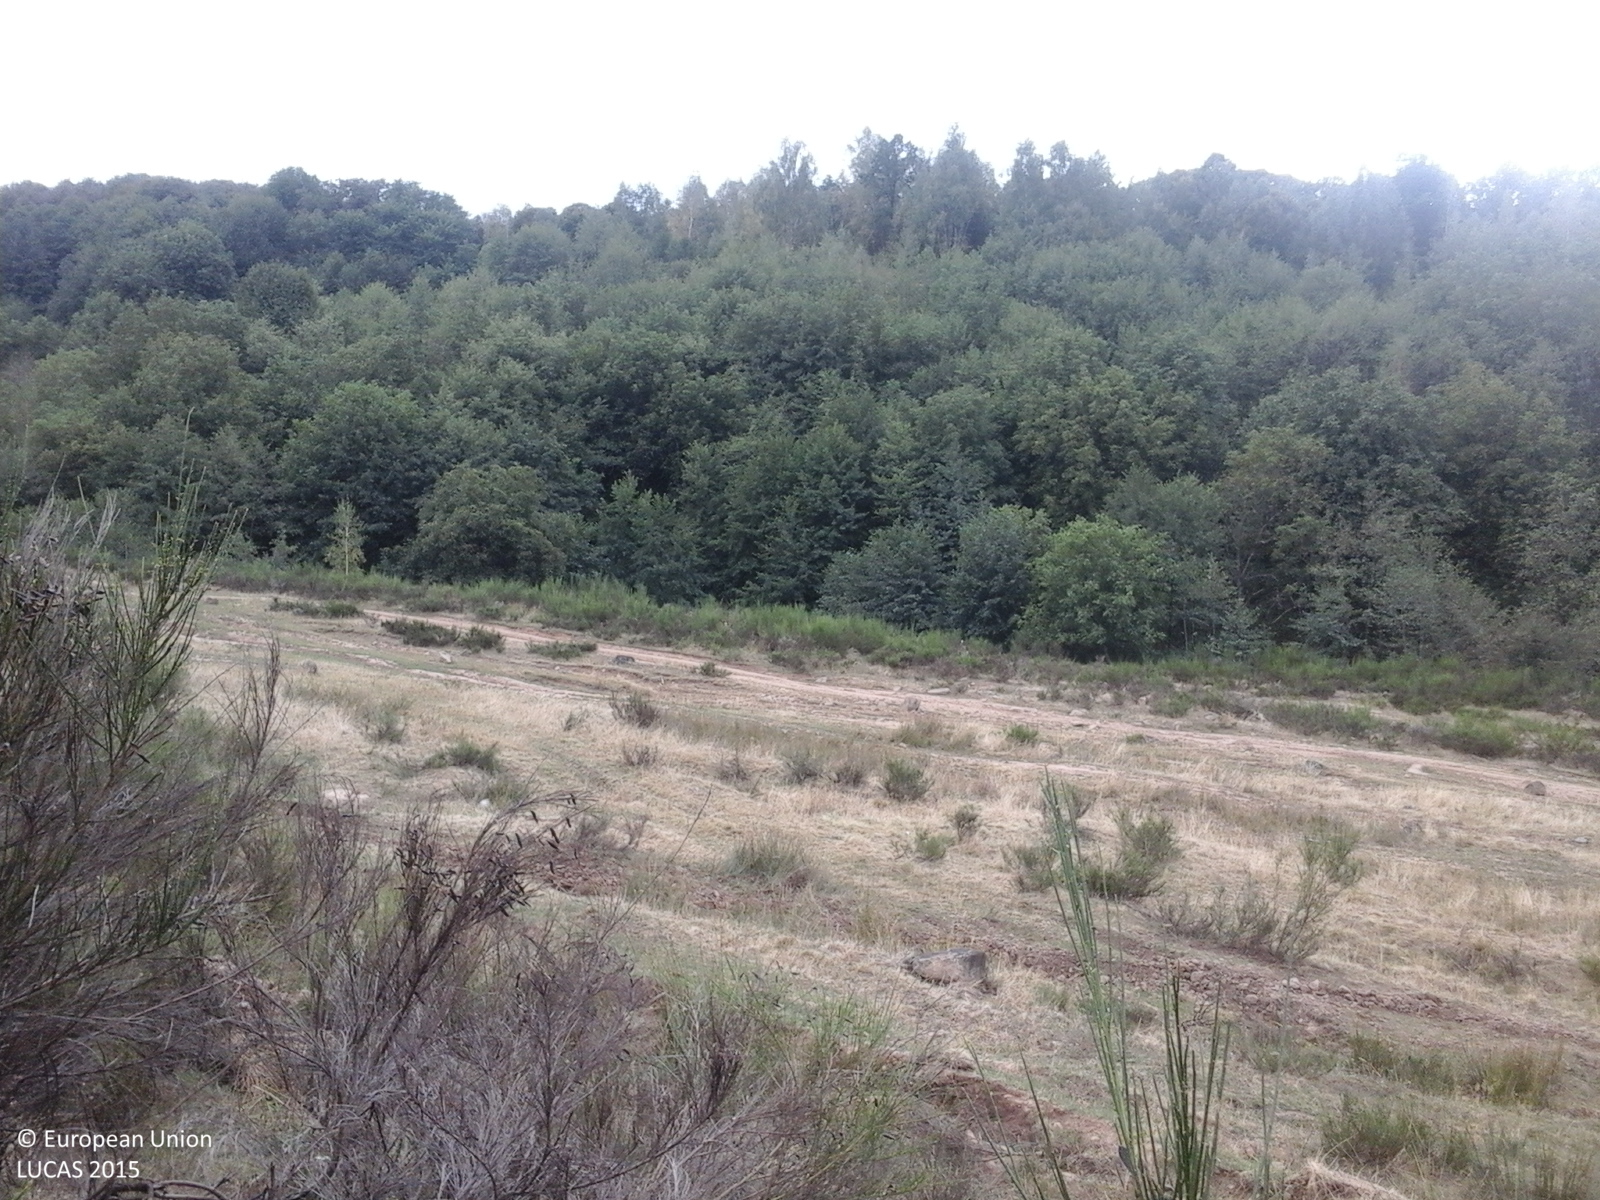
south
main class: Shrubland
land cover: Shrubland with sparse tree cover
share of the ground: > 75 %
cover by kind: herbaceous plants 70 %, shrubs 25 %, broadleaved forest trees 5 %
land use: Semi-natural and natural areas not in use
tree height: < 5 m
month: September
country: RO
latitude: 47.8072
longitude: 23.3593
